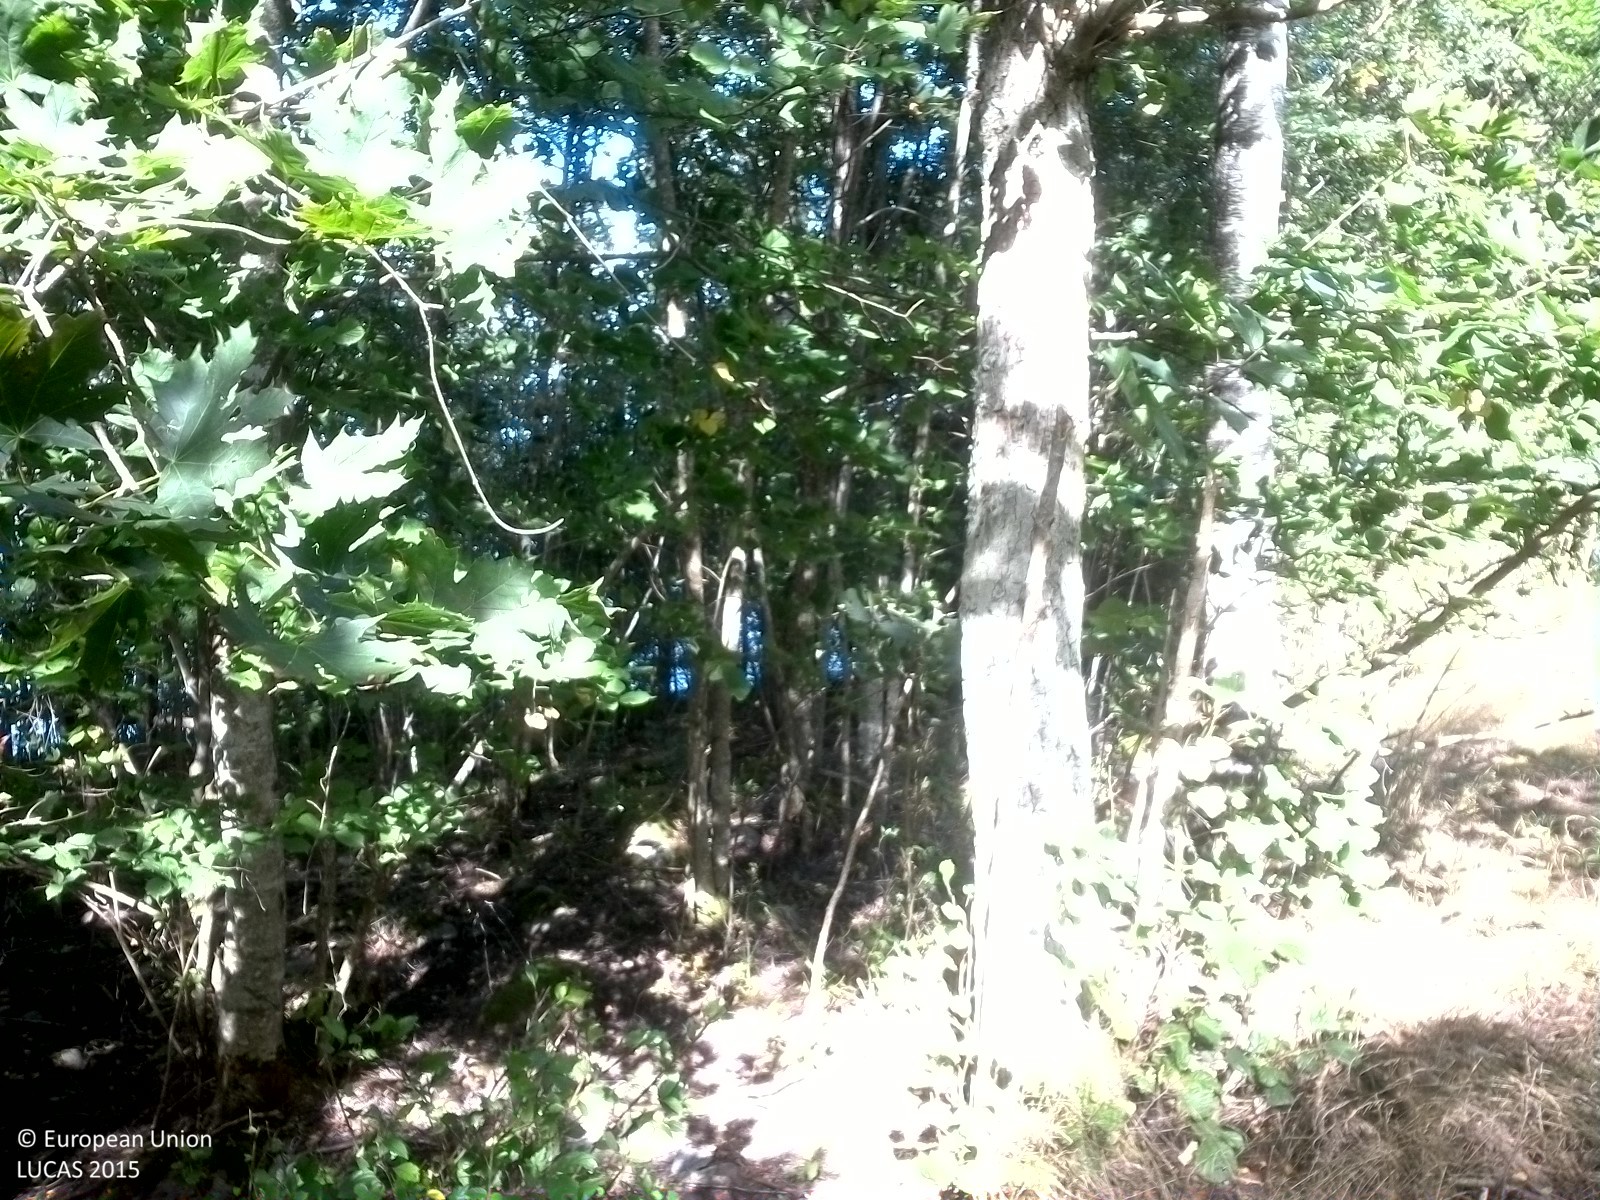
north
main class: Woodland
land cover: Broadleaved woodland
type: hemiboreal forest and nemoral coniferous forest and mixed broadleaved-coniferous forest
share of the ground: 50 - 75 %
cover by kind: broadleaved forest trees 60 %, unconsolidated bare surface 20 %, herbaceous plants 10 %, shrubs 5 %, lichens and mosses 5 %
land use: Forestry
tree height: > 5 m
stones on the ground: 10 - 25 %
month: September
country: SE
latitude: 59.1388
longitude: 15.8477
